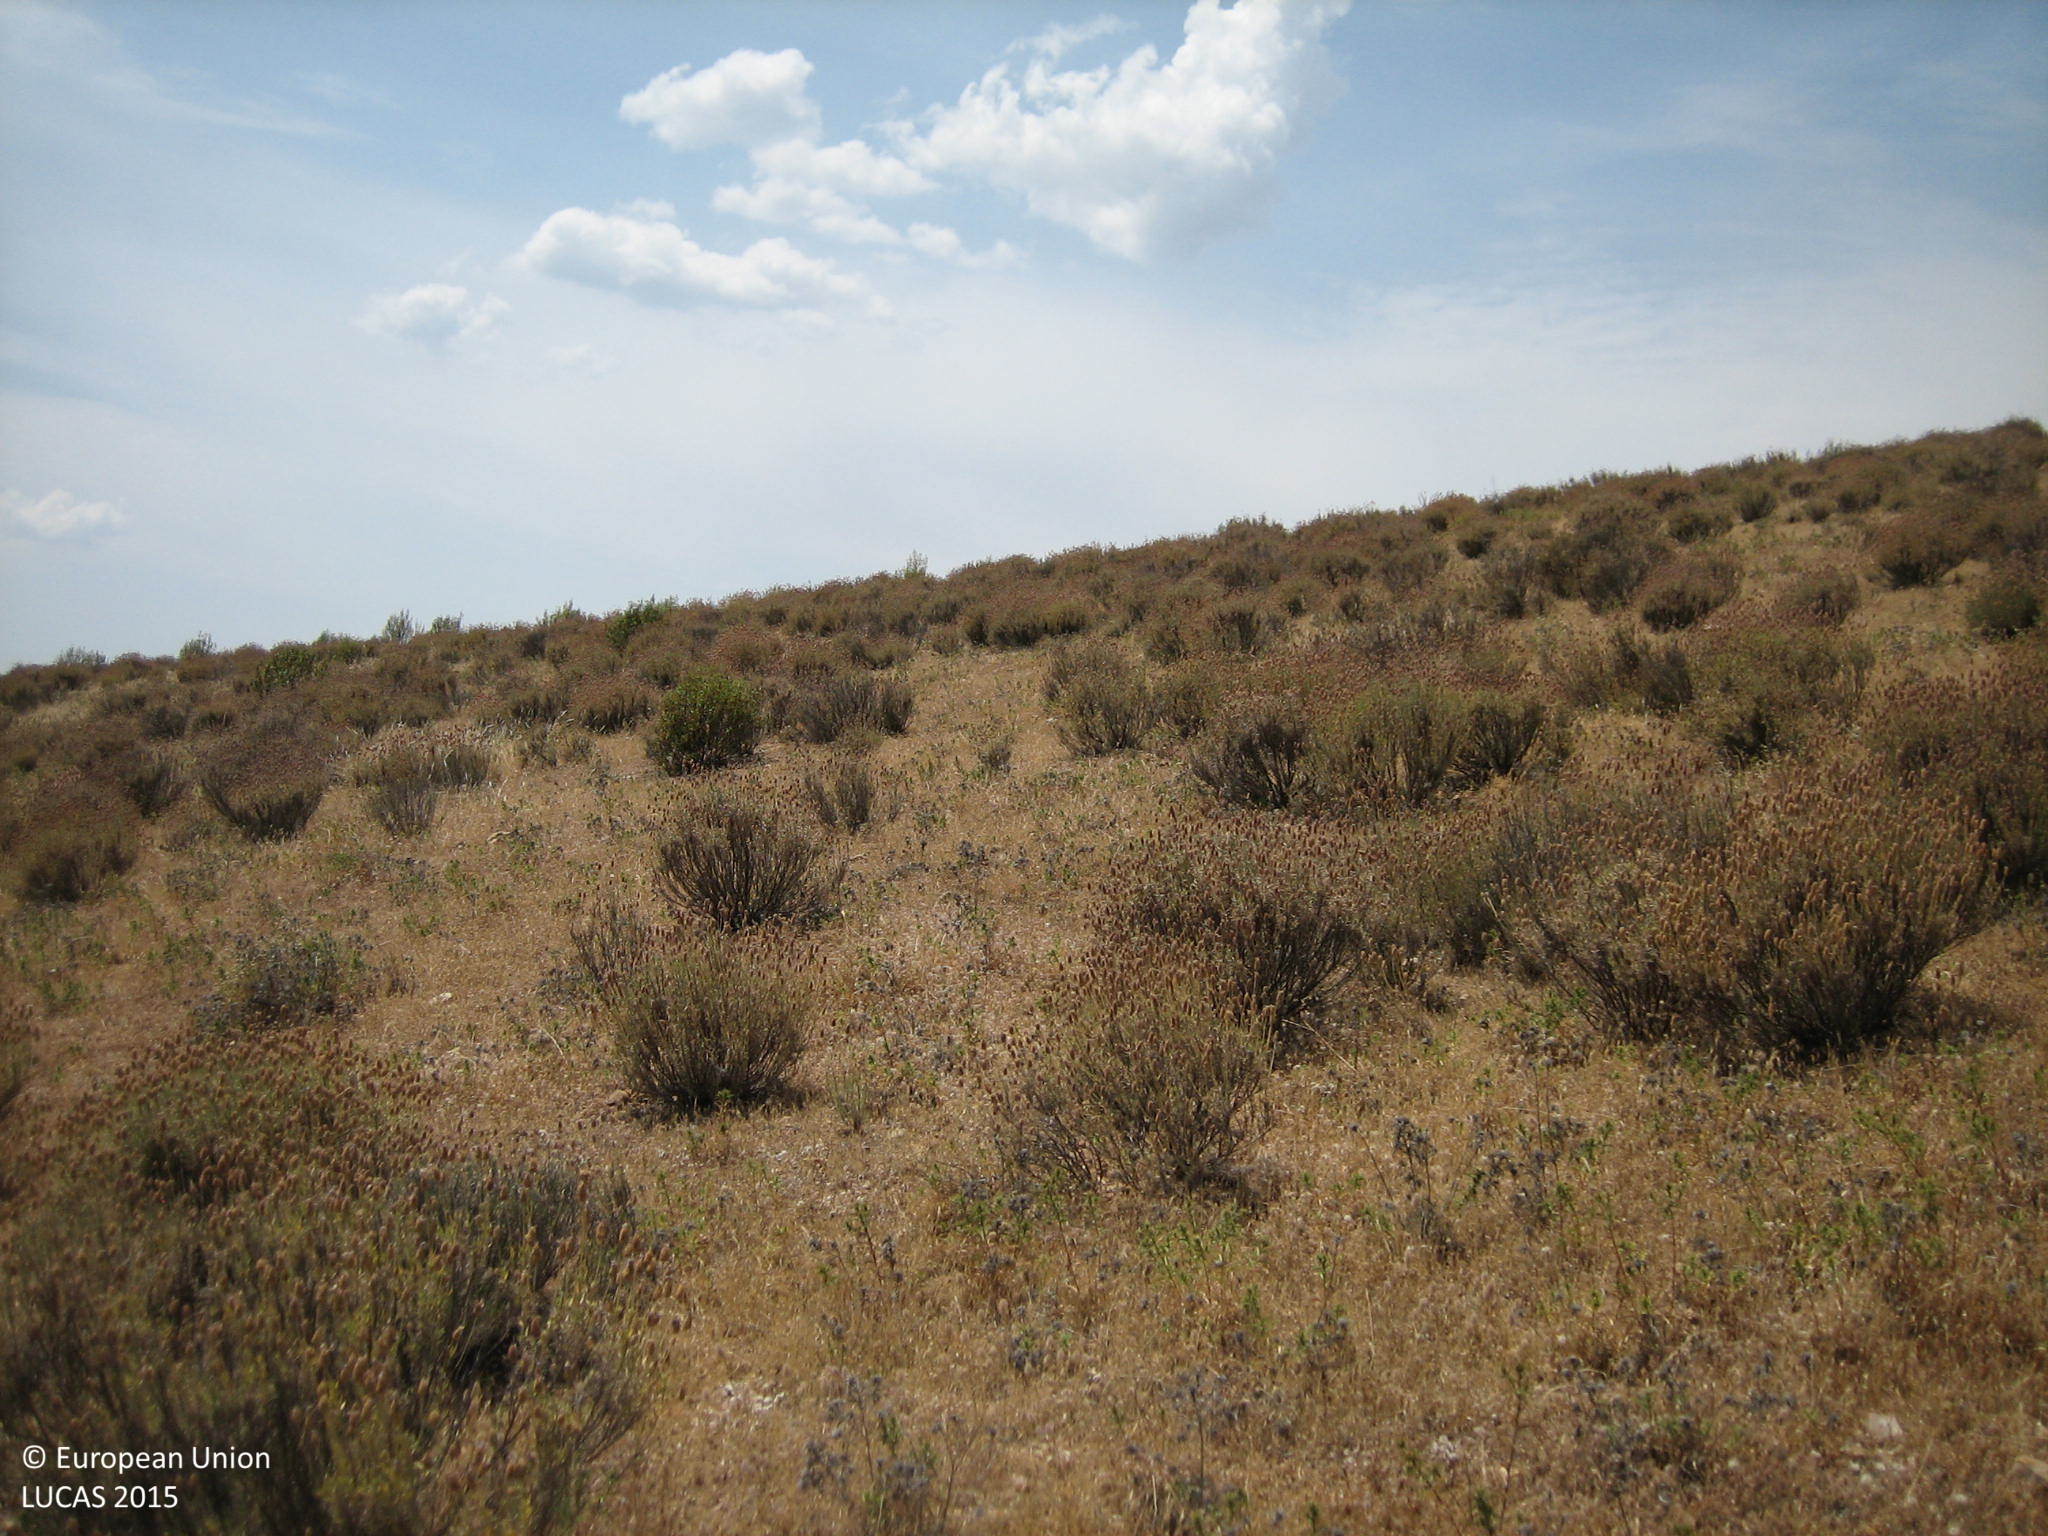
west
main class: Shrubland
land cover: Shrubland without tree cover
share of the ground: 50 - 75 %
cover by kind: shrubs 50 %, herbaceous plants 50 %
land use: Agriculture (excluding fallow land and kitchen gardens)
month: June
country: ES
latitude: 39.2035
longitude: -4.6121
